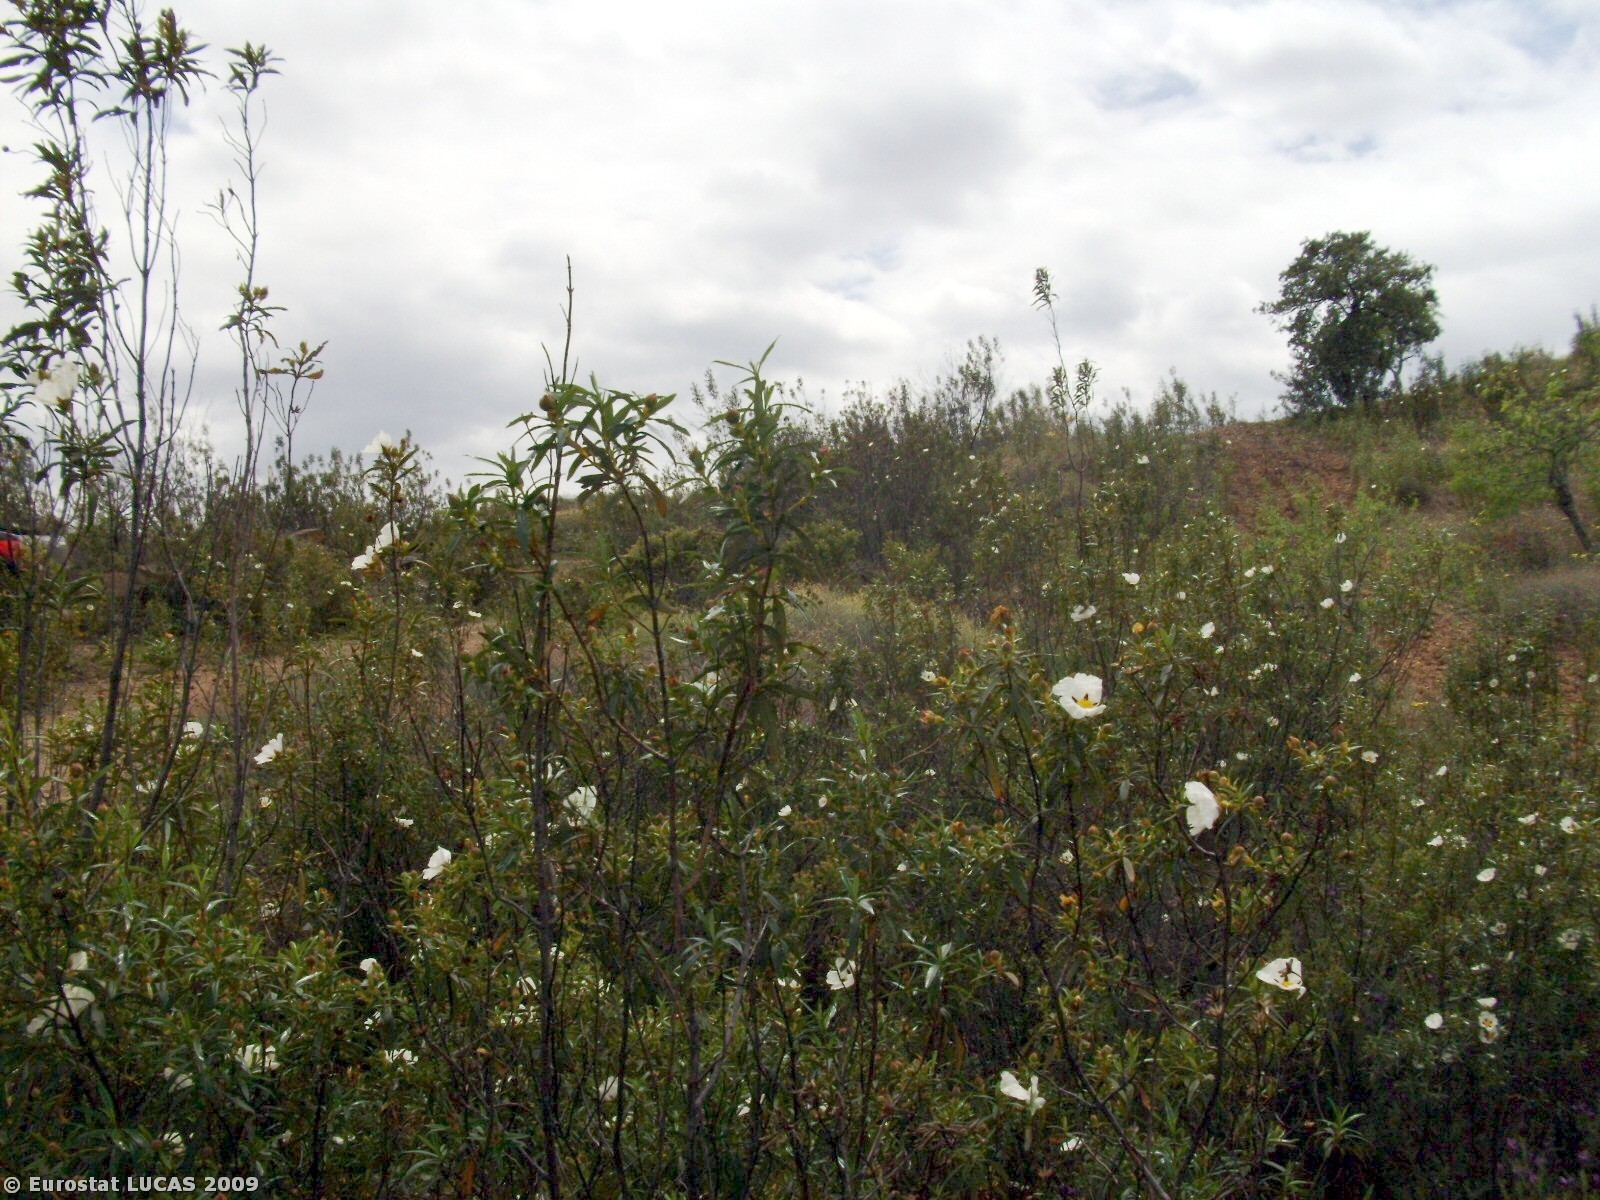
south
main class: Bare land
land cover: Bare land
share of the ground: > 75 %
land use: Unused
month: April
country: PT
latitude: 37.3050
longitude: -7.6425
